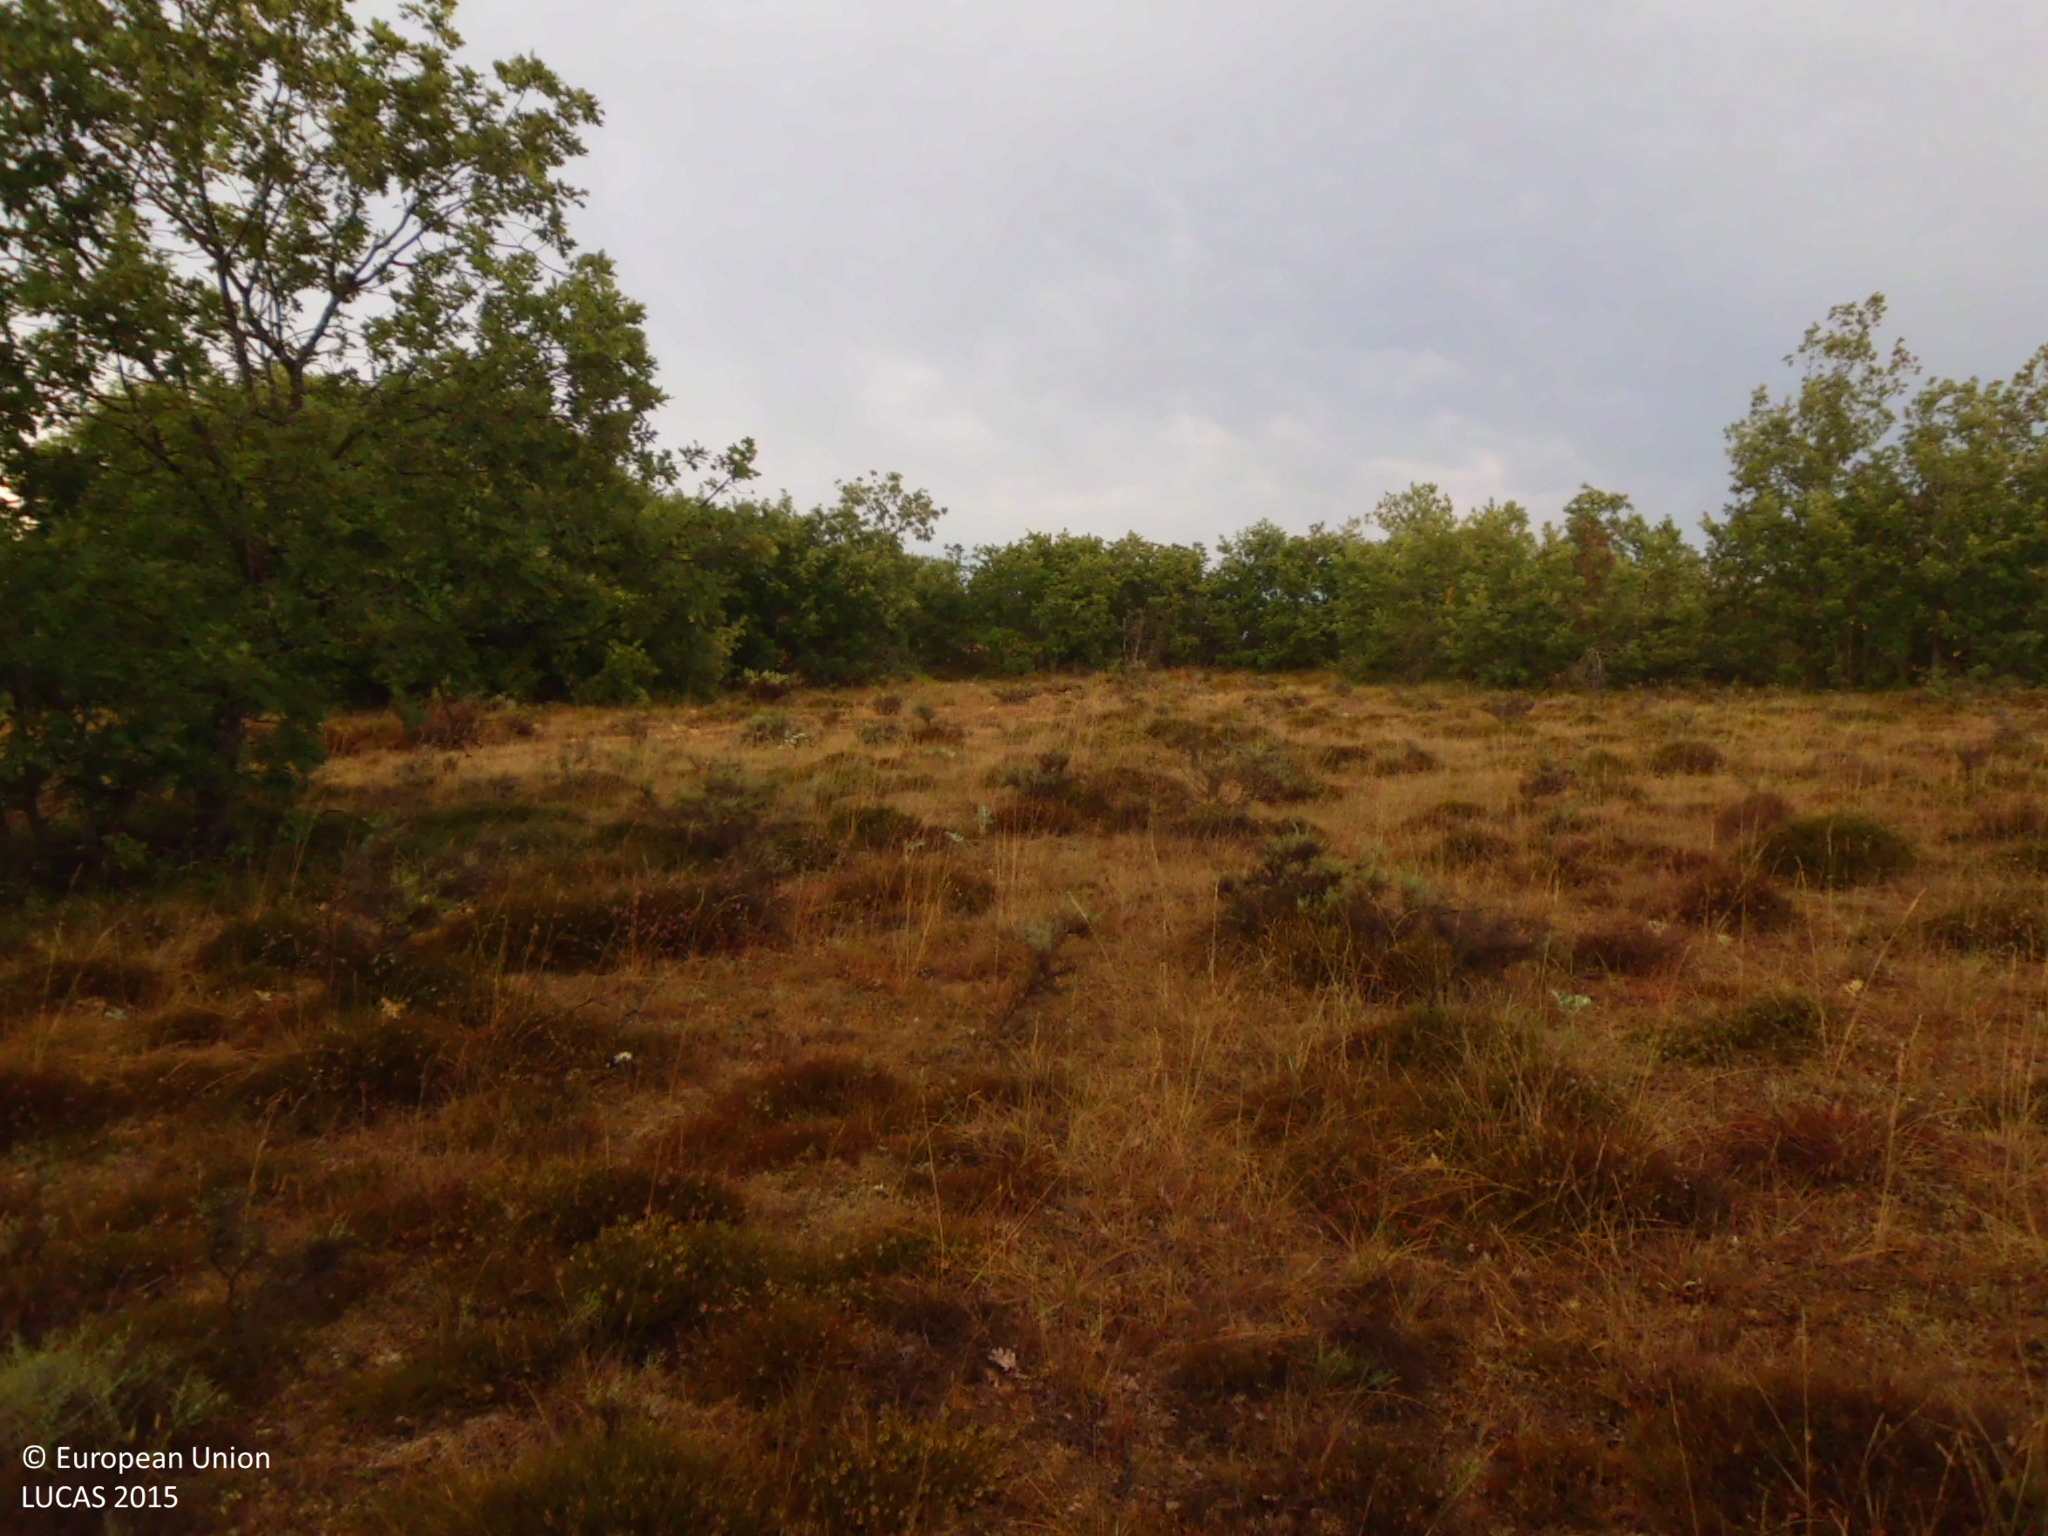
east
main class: Woodland
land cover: Broadleaved woodland
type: acidophilous oak and oak-birch forest
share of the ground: 25 - 50 %
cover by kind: herbaceous plants 50 %, broadleaved forest trees 25 %, shrubs 25 %
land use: Semi-natural and natural areas not in use
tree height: > 5 m
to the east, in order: Broadleaved woodland; Tracks; Broadleaved woodland; Tracks; Broadleaved woodland; Grassland without tree/shrub cover
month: July
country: ES
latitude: 42.6612
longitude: -4.4106
